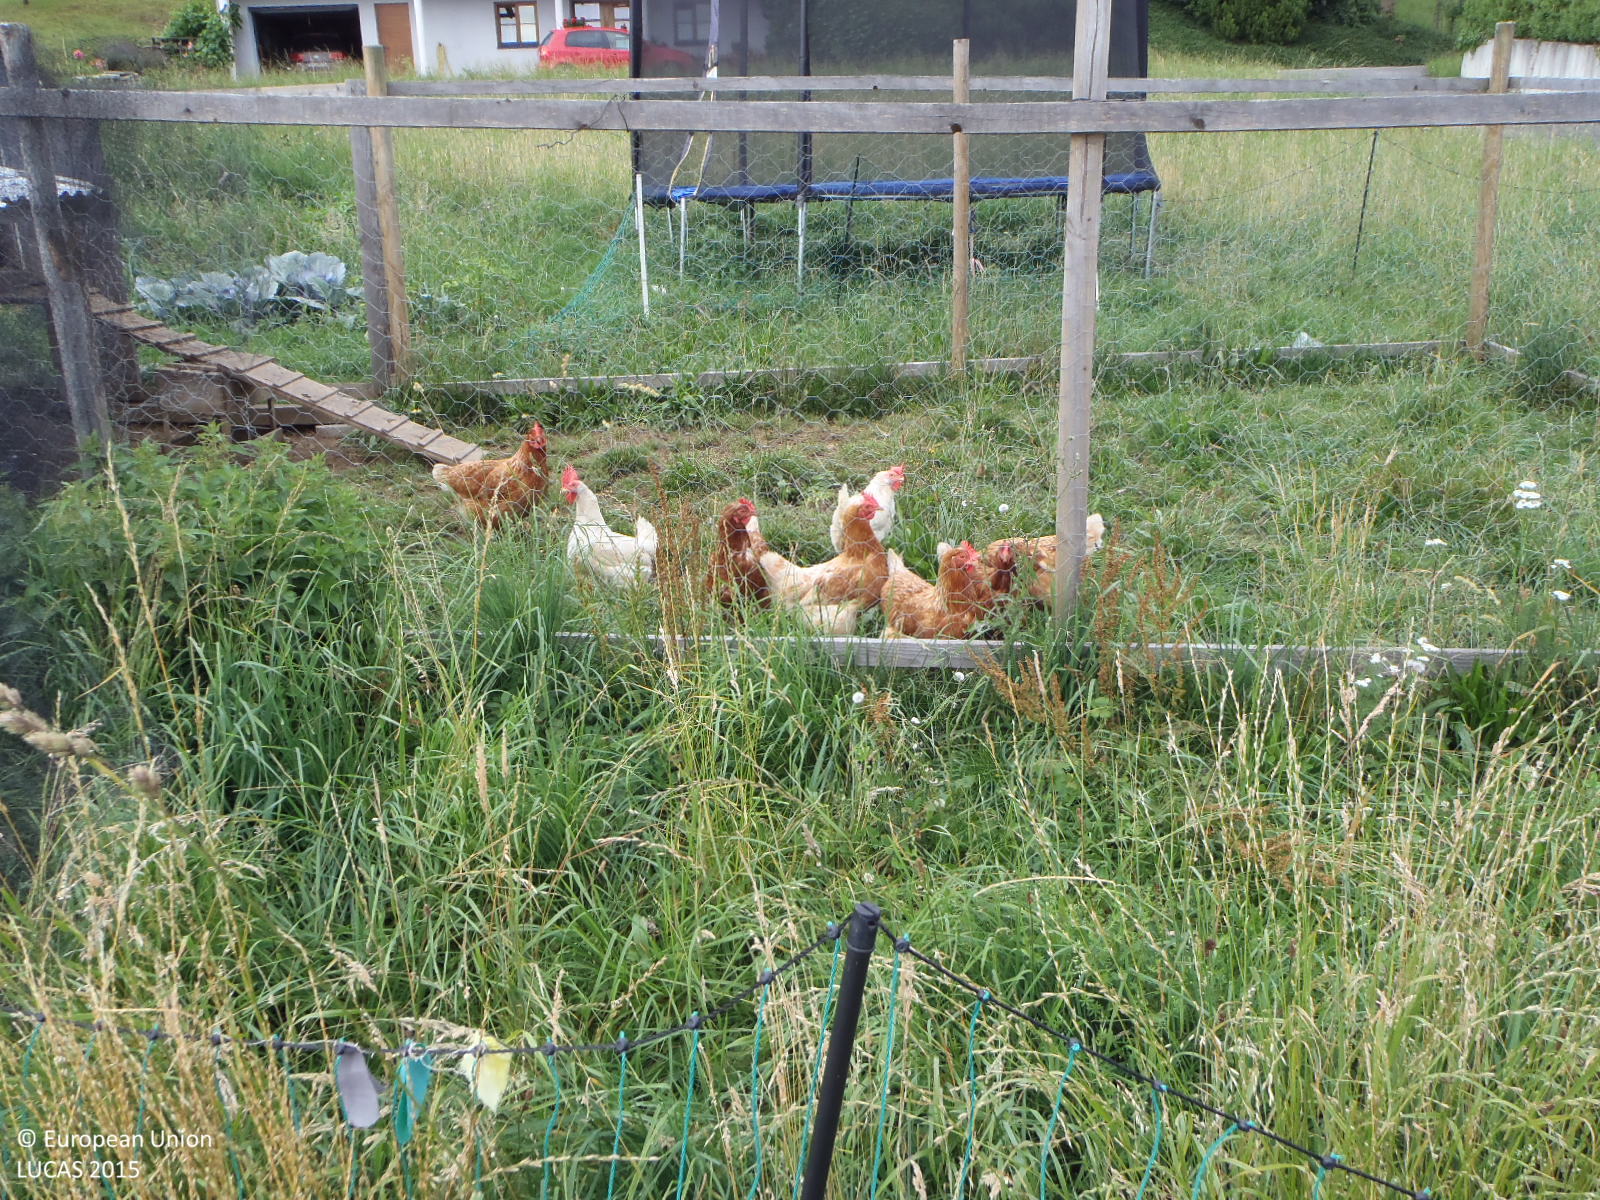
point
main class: Grassland
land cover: Grassland without tree/shrub cover
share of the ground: > 75 %
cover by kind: herbaceous plants 100 %
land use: Agriculture (excluding fallow land and kitchen gardens)
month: July
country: AT
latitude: 47.2511
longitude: 9.6700
